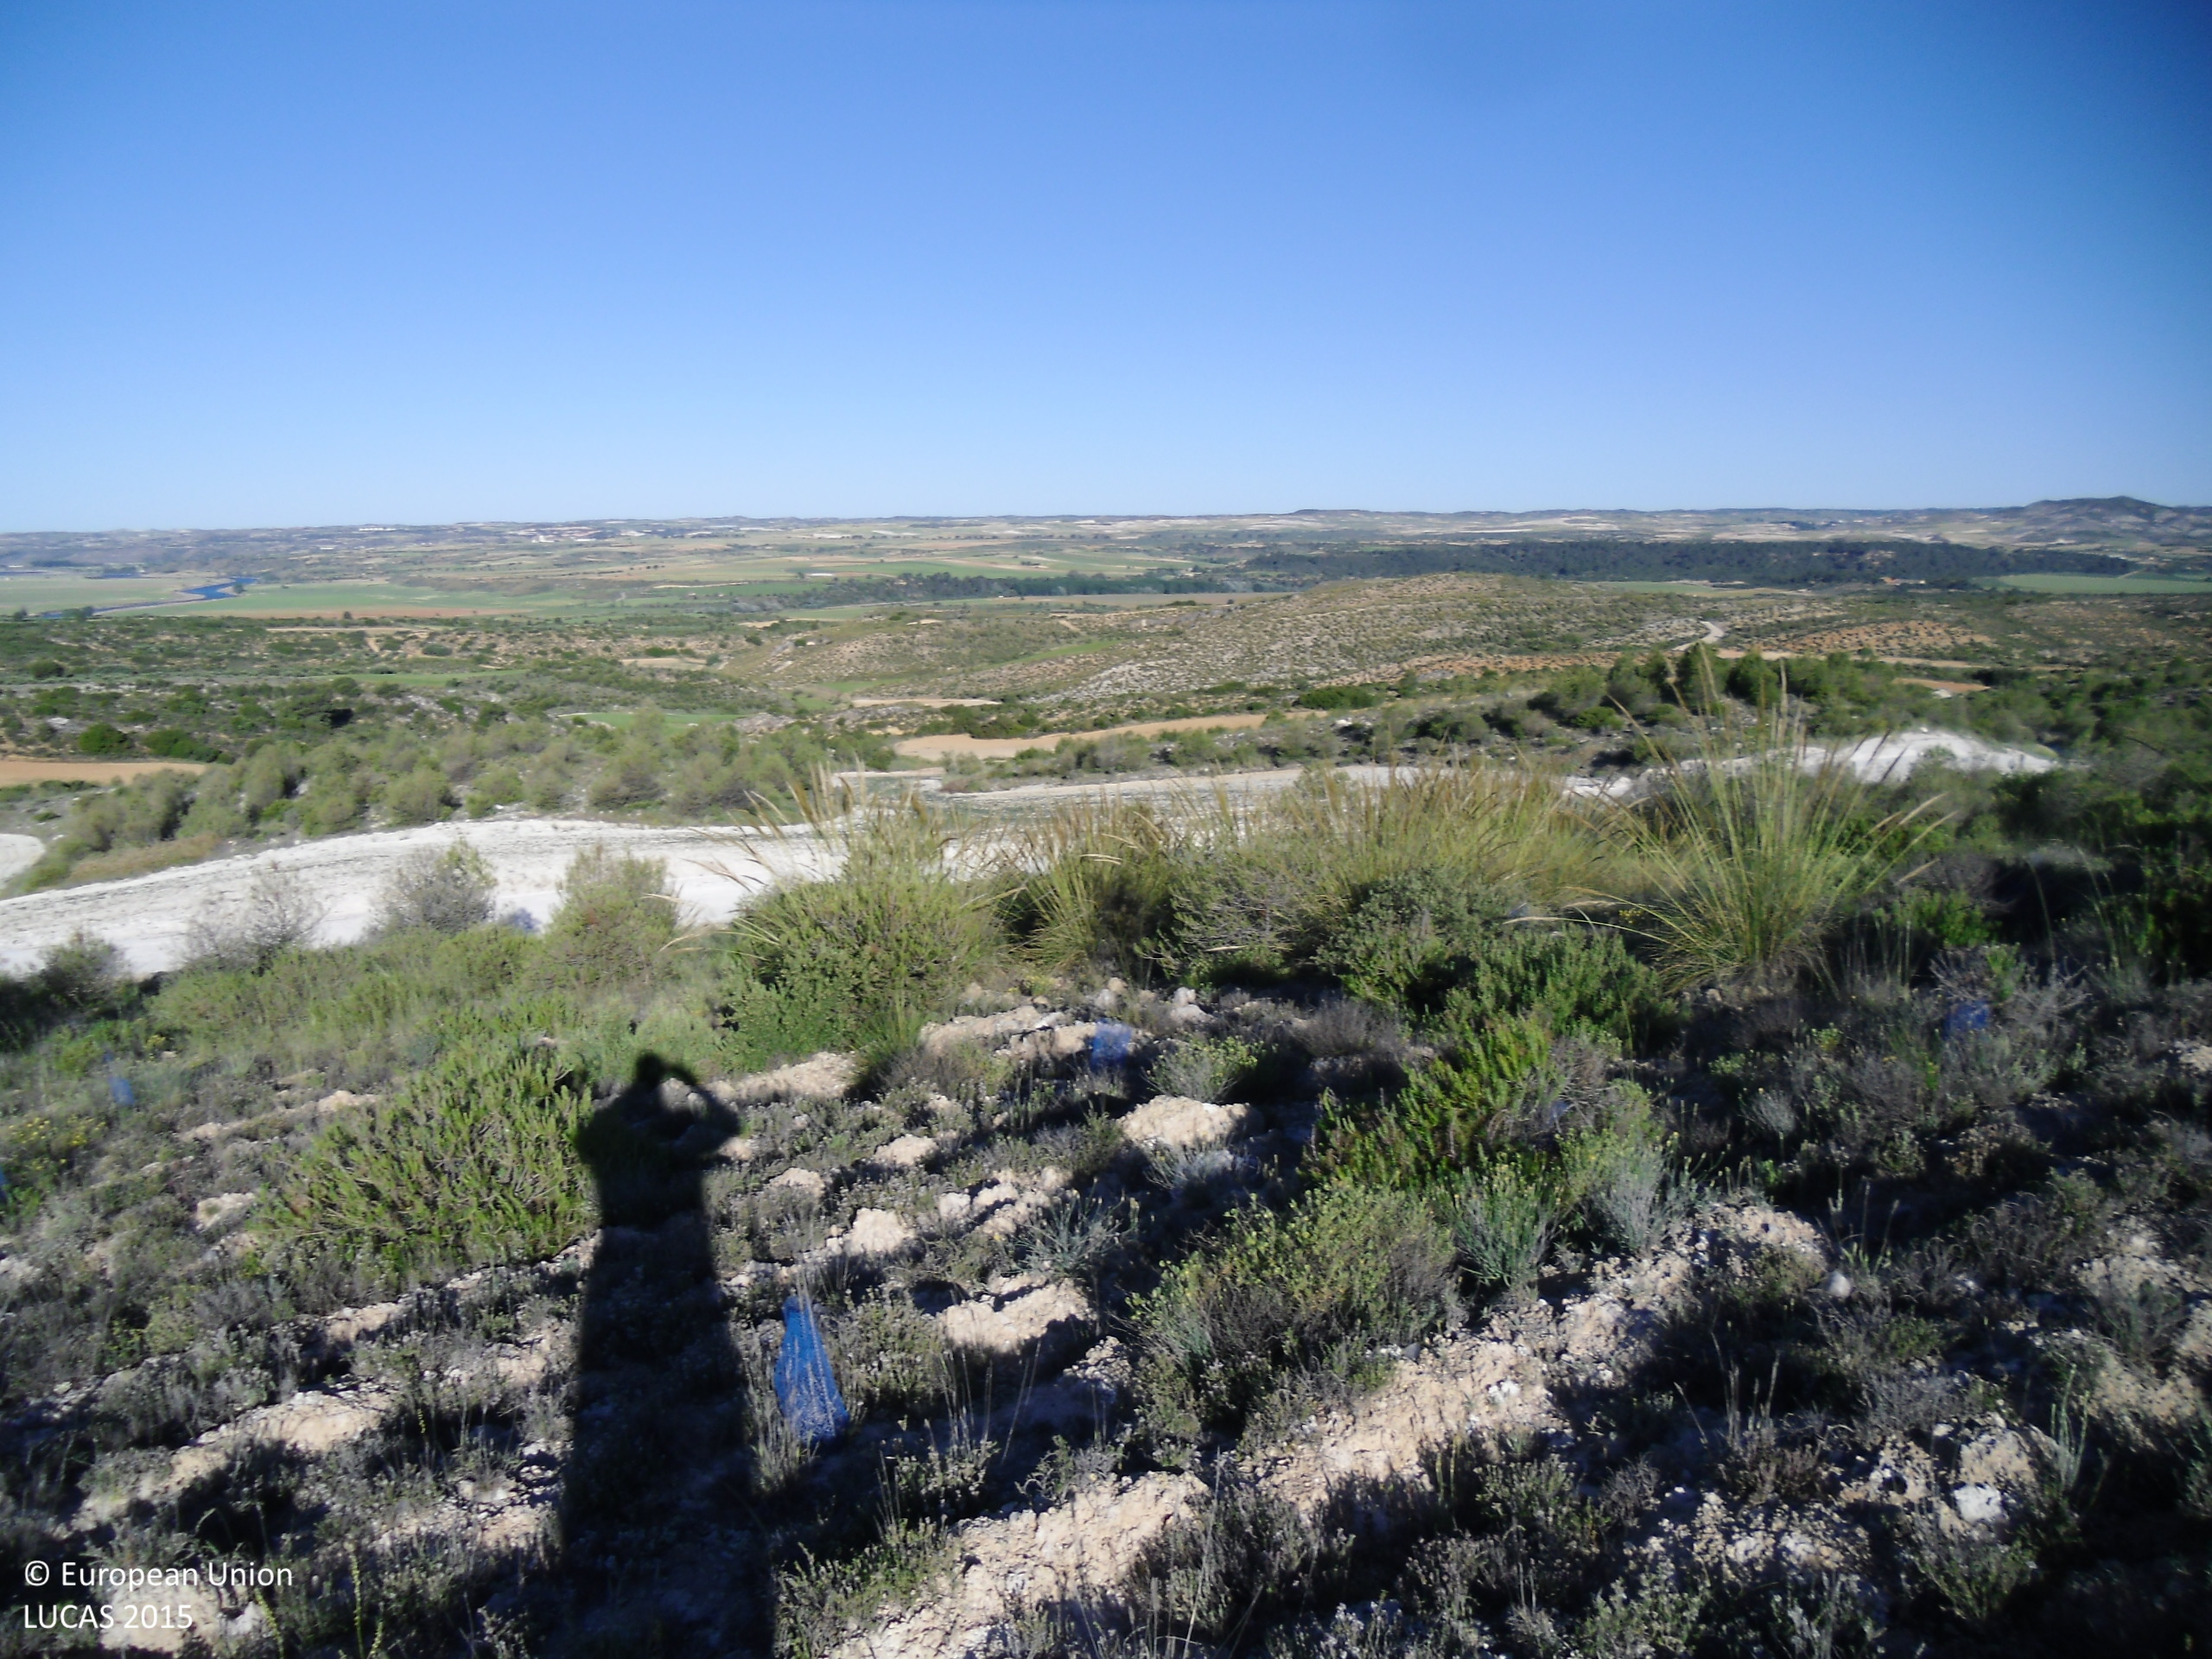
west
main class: Woodland
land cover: Pine dominated coniferous woodland
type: coniferous forest of the mediterranean region
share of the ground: 10 - 25 %
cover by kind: shrubs 55 %, herbaceous plants 25 %, coniferous forest trees 10 %, unconsolidated bare surface 10 %
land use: Semi-natural and natural areas not in use
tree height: < 5 m
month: May
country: ES
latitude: 40.3130
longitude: -2.8640
